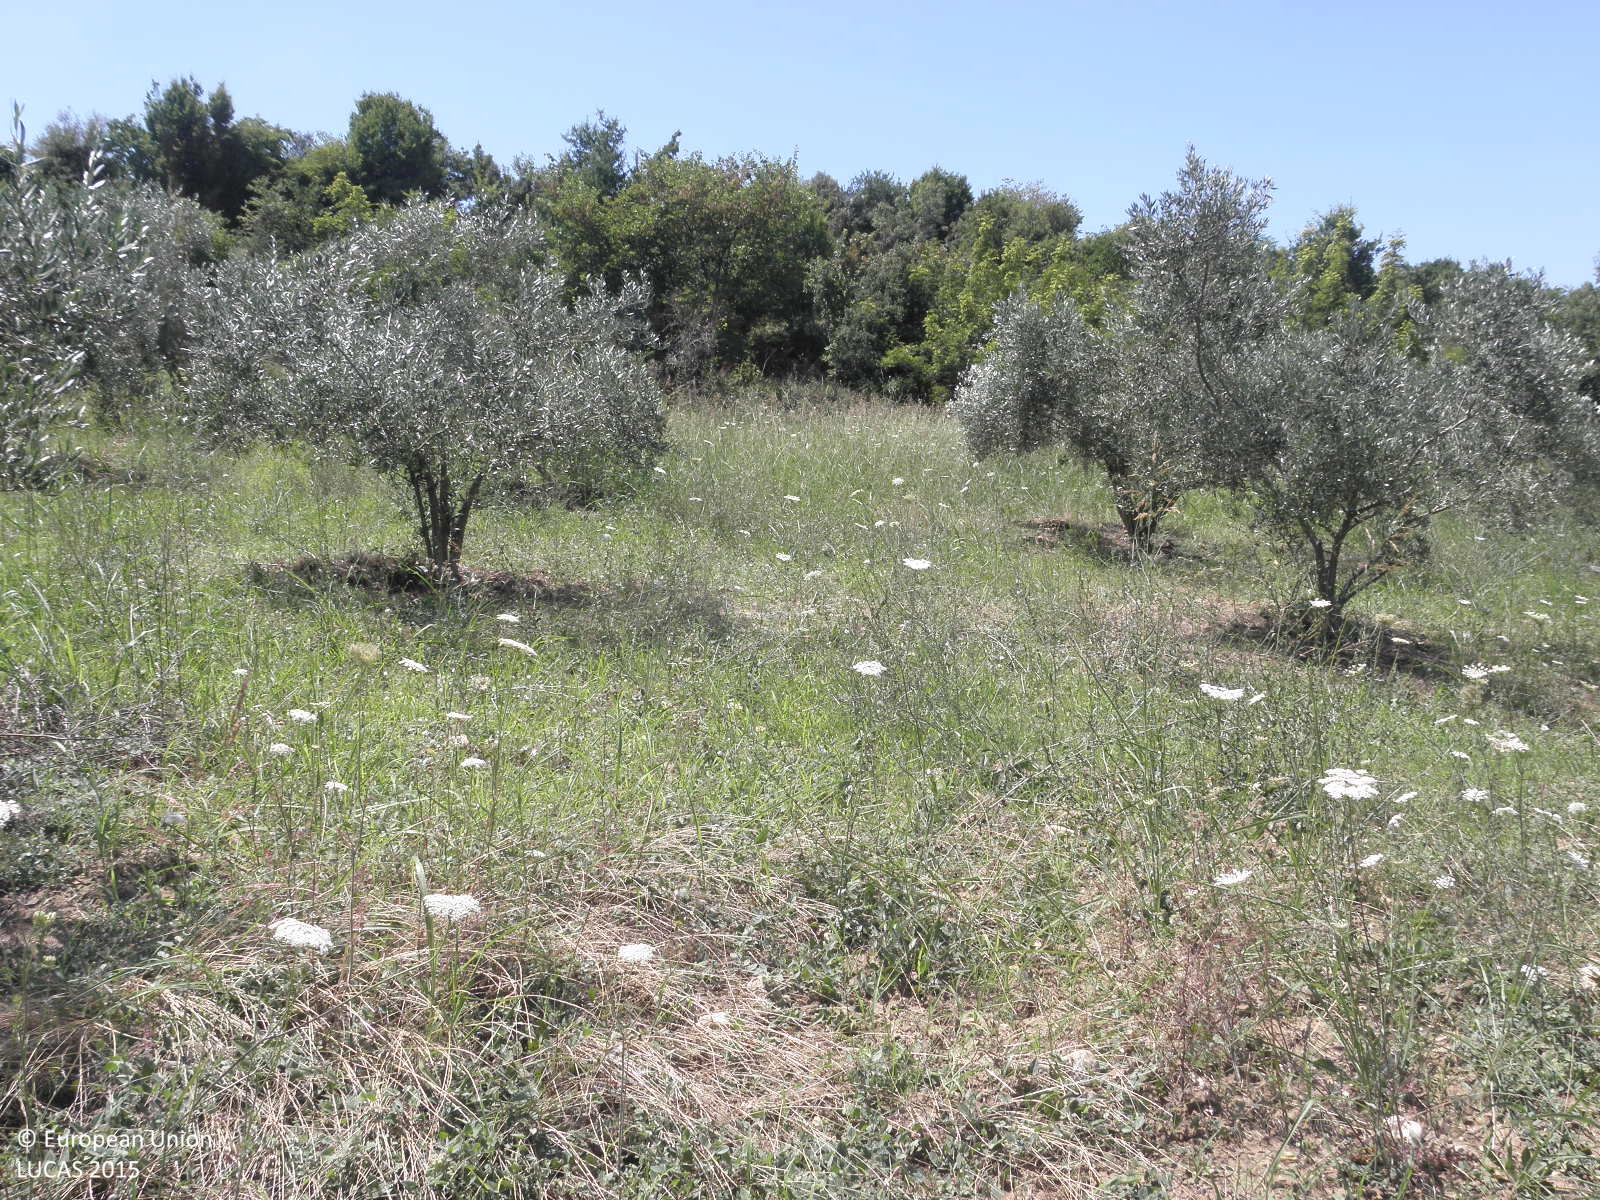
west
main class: Cropland
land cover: Olive groves
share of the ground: 50 - 75 %
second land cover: Spontaneously vegetated surfaces
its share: > 75 %
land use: Agriculture (excluding fallow land and kitchen gardens)
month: July
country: GR
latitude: 40.4533
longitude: 22.4874
